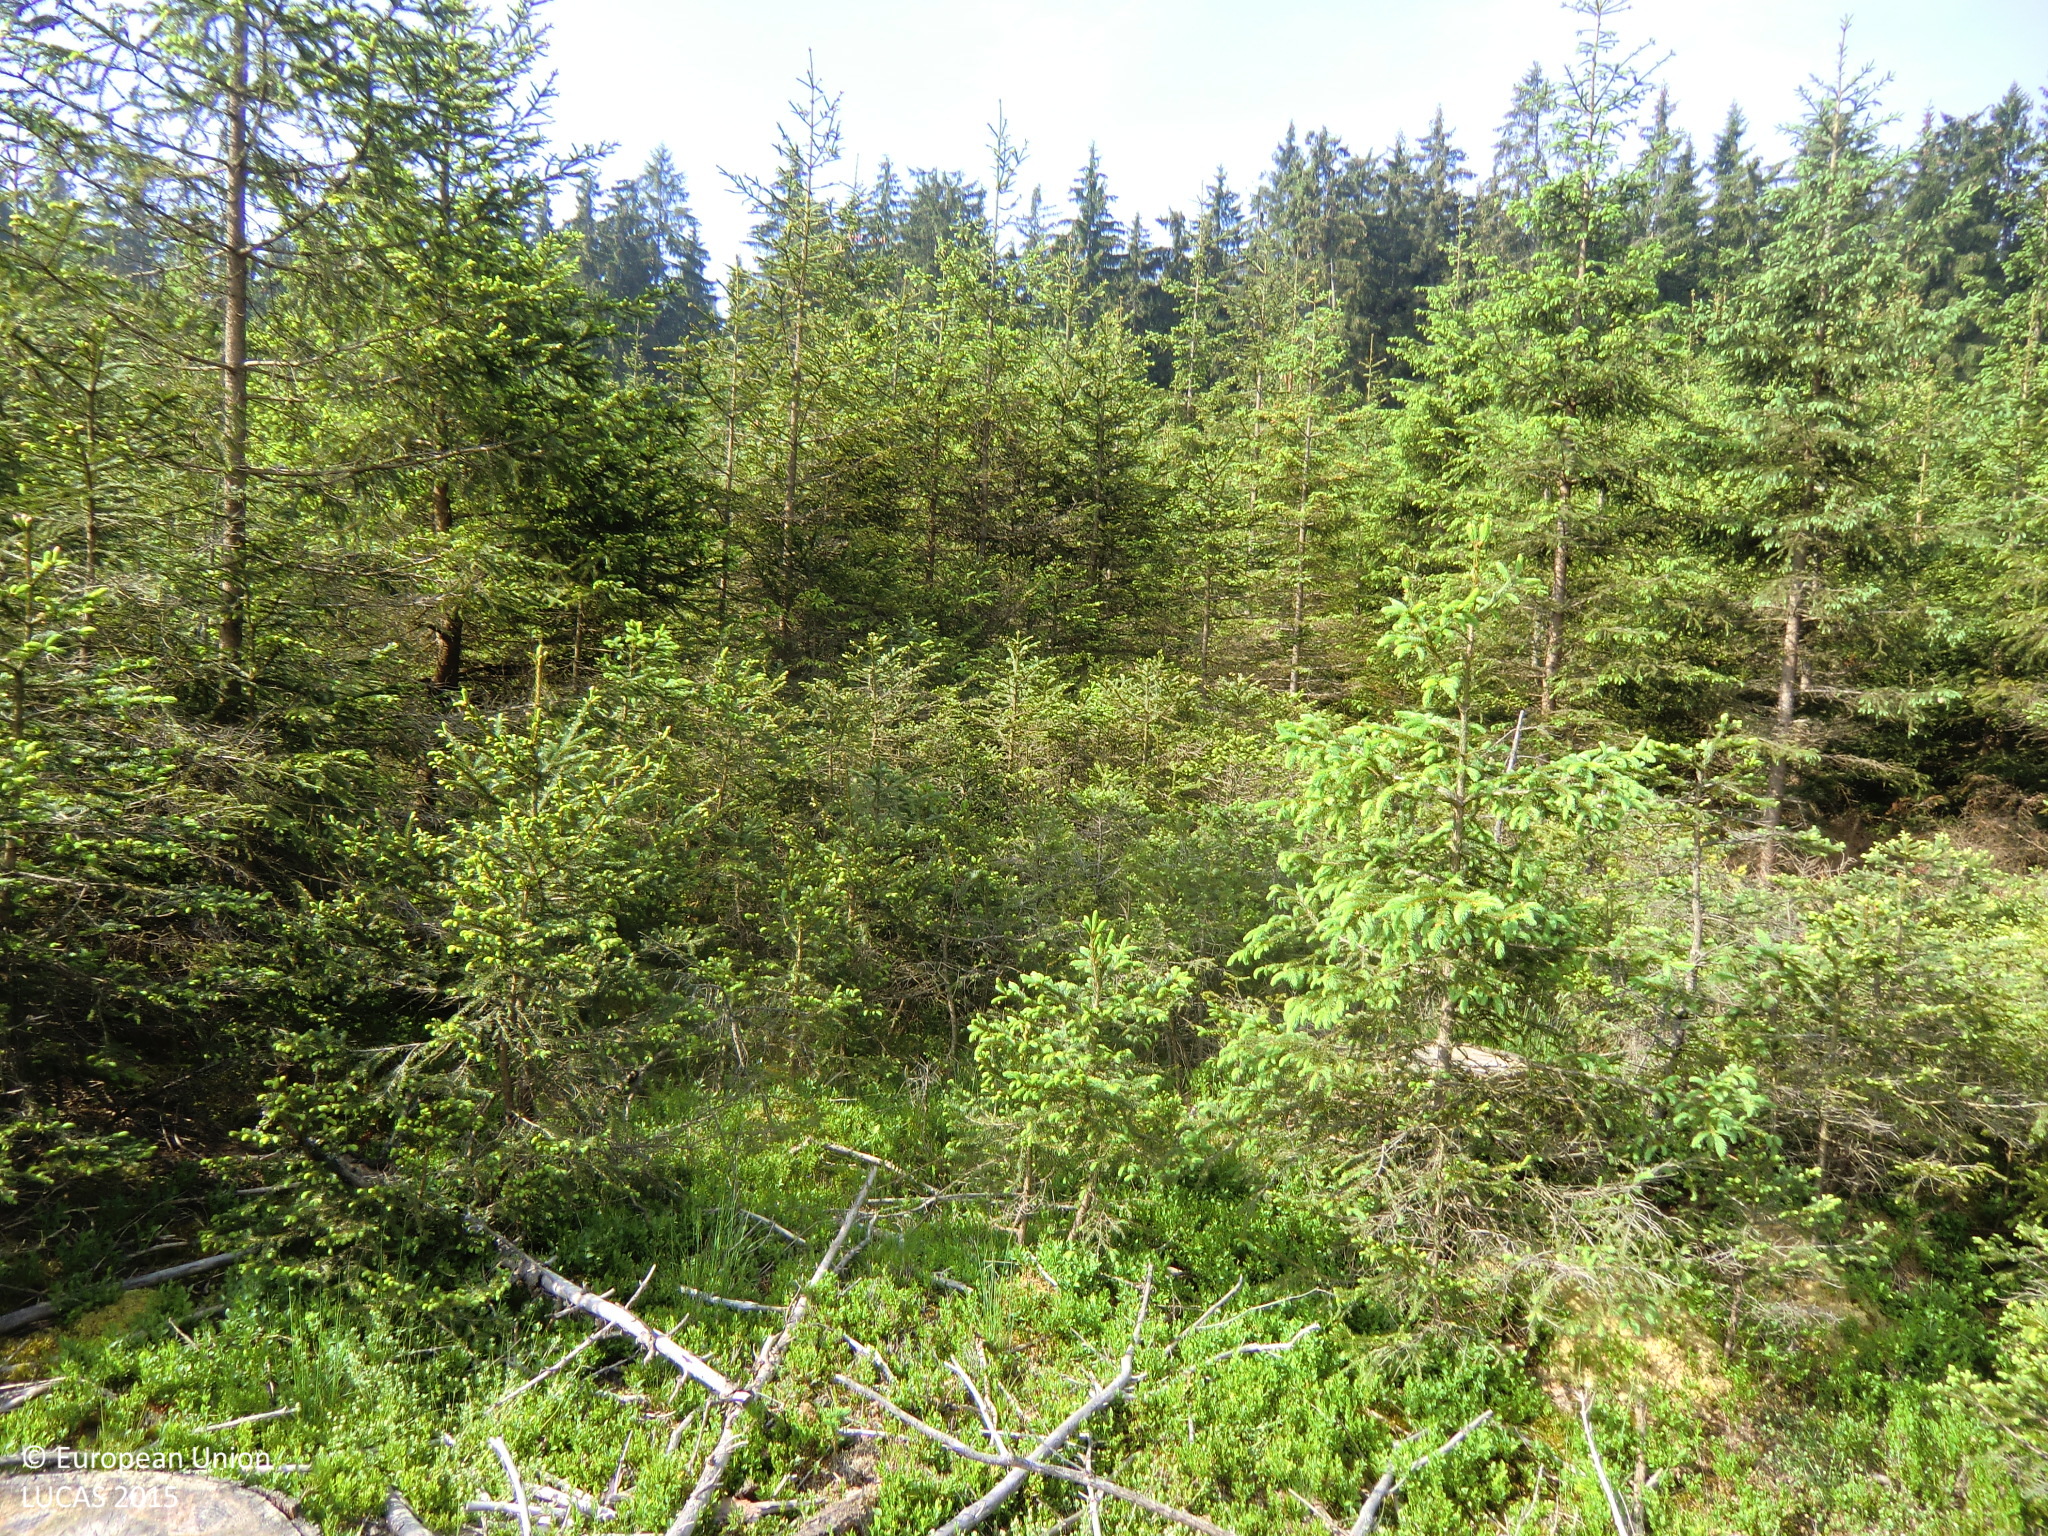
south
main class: Woodland
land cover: Spruce dominated coniferous woodland
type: hemiboreal forest and nemoral coniferous forest and mixed broadleaved-coniferous forest
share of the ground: 50 - 75 %
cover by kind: coniferous forest trees 60 %, herbaceous plants 20 %, lichens and mosses 10 %, unconsolidated bare surface 10 %
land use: Forestry
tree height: < 5 m
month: June
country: AT
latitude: 48.5523
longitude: 14.7836
